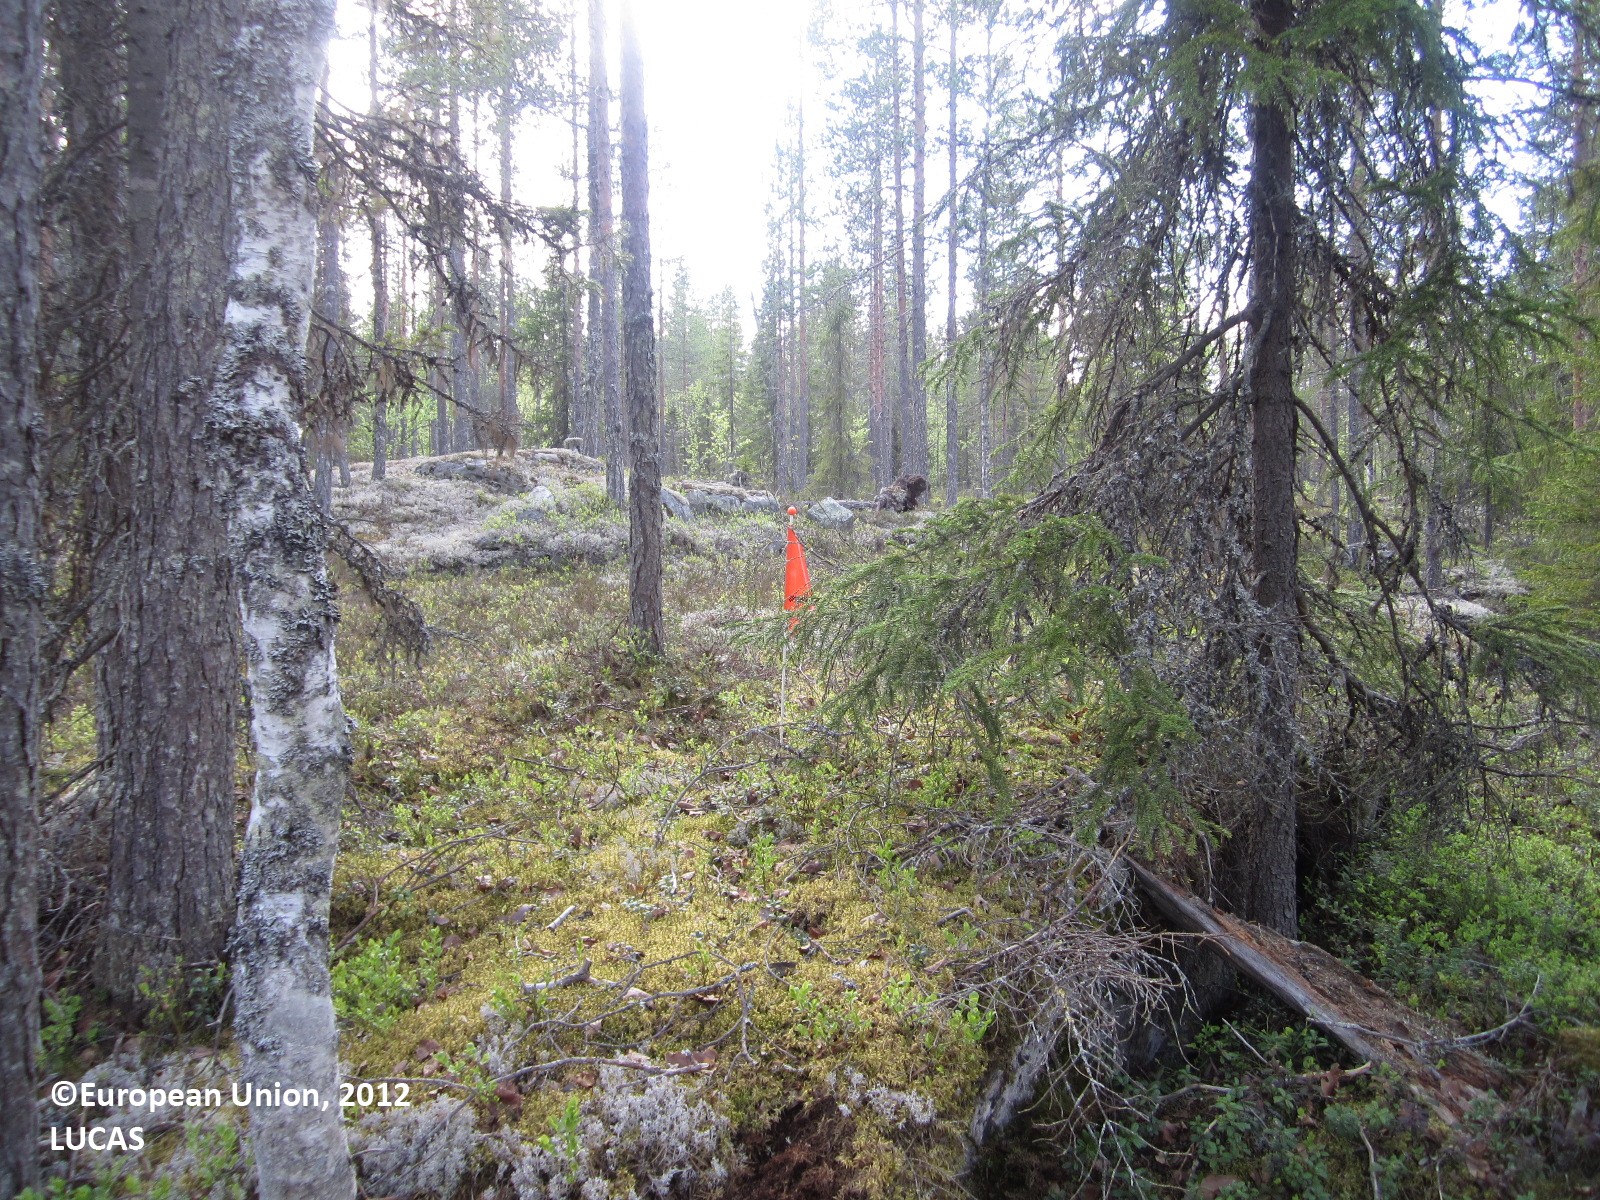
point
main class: Woodland
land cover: Other coniferous woodland
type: boreal forest
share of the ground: 50 - 75 %
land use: Semi-natural and natural areas not in use
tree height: > 5 m
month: June
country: FI
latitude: 64.5921
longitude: 28.5807
